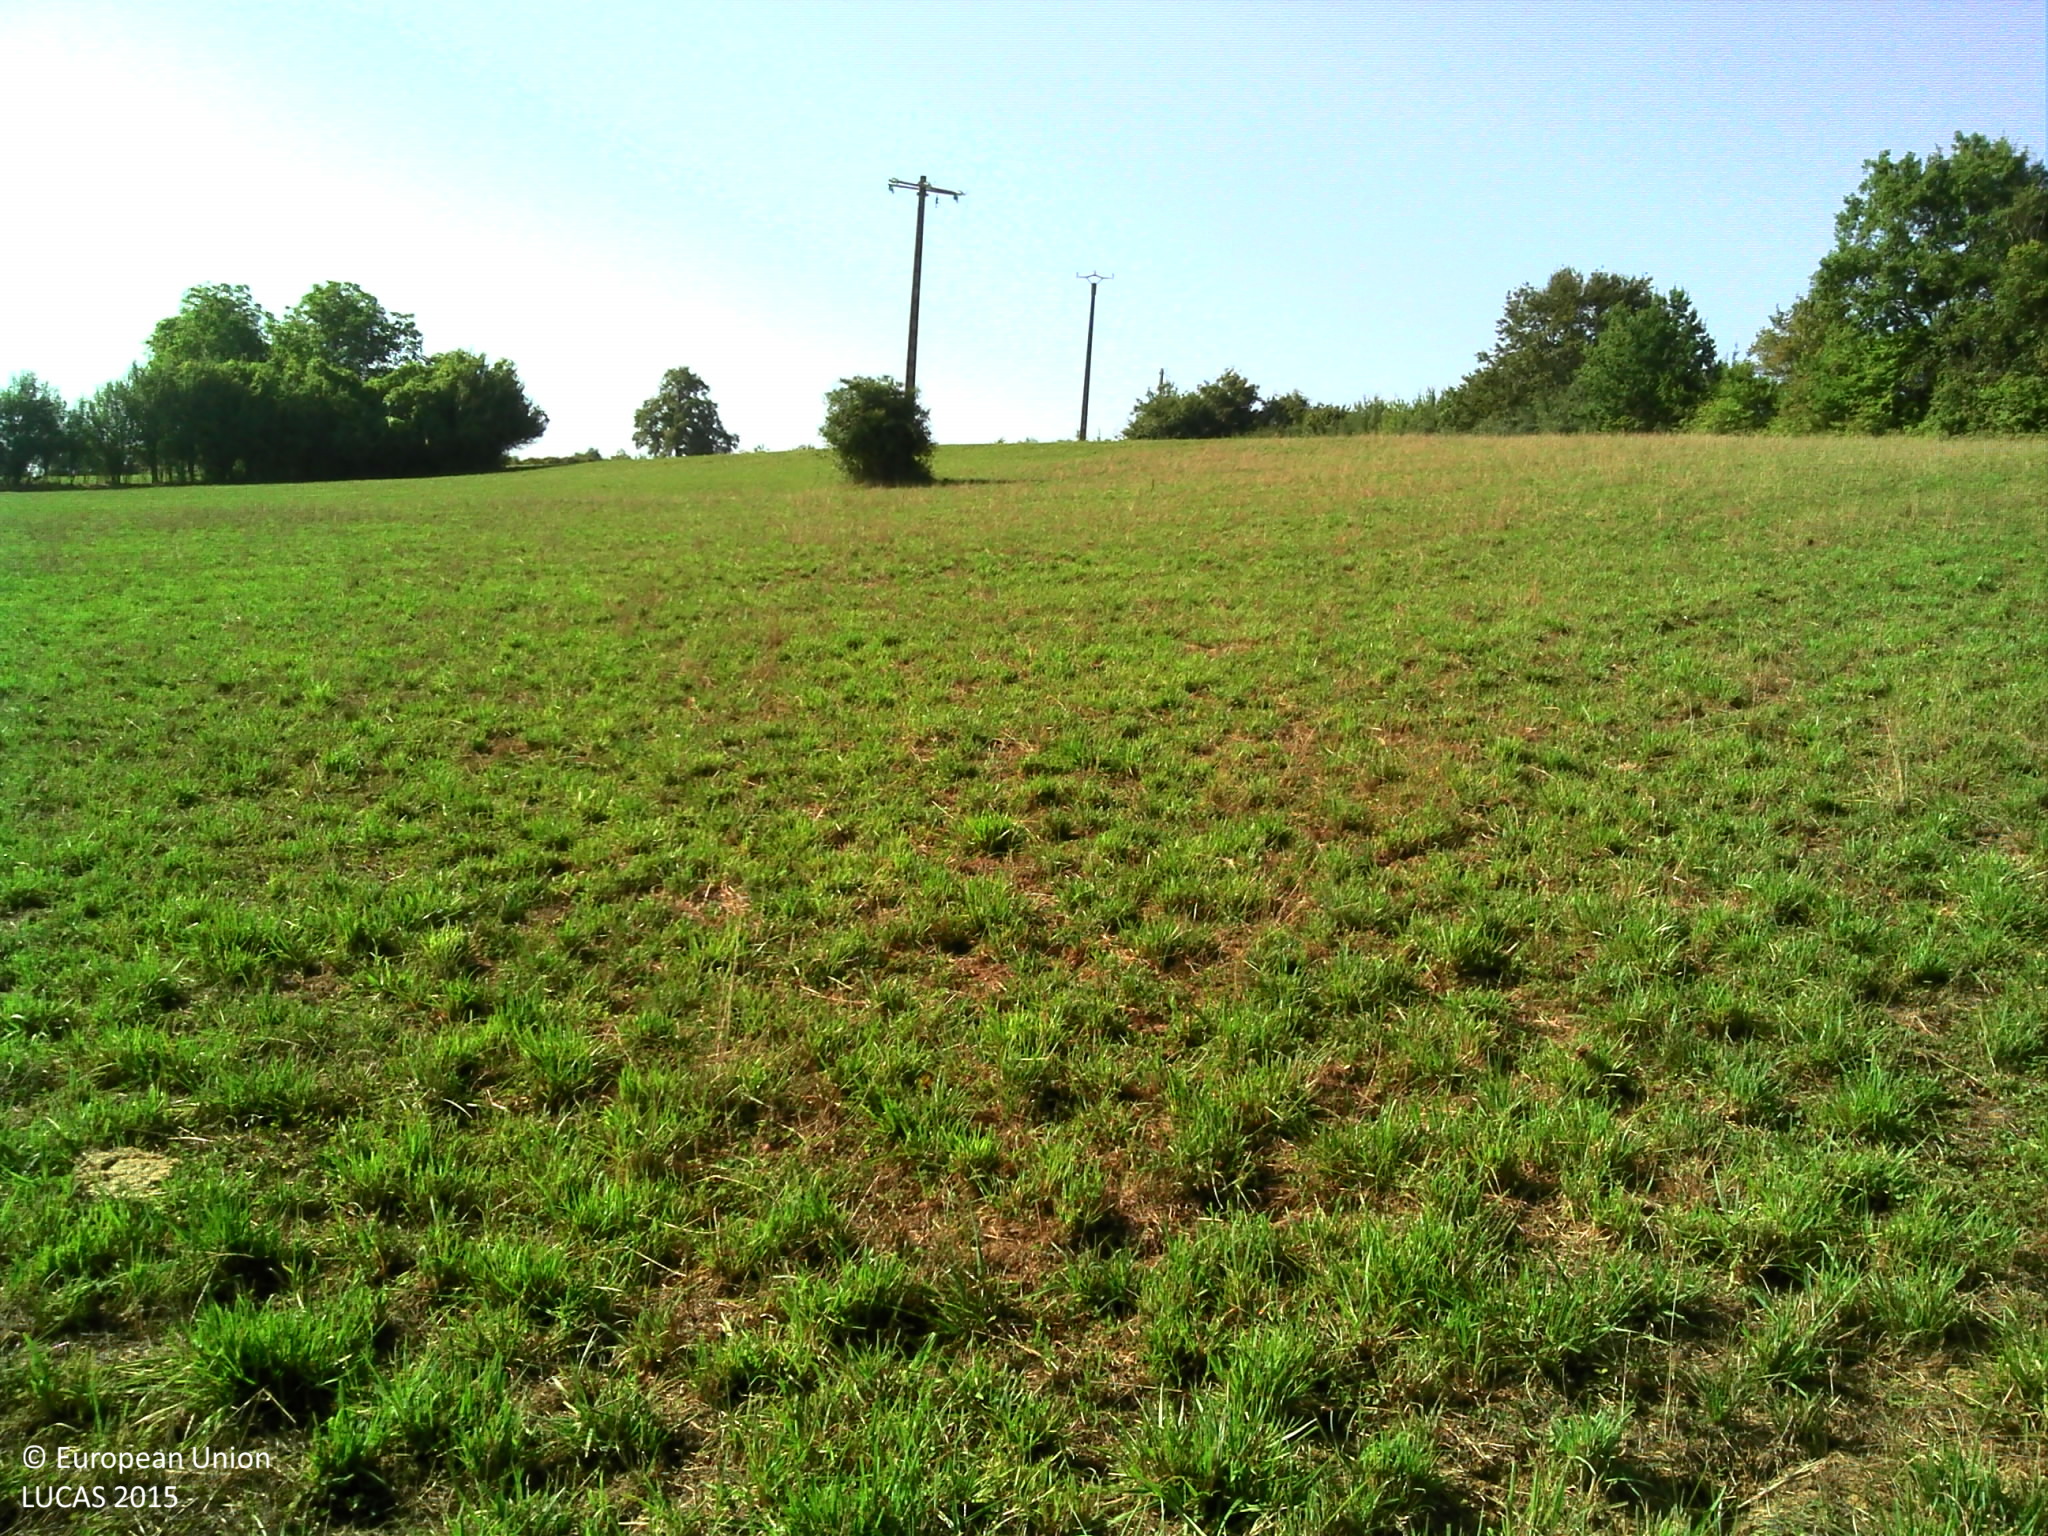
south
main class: Grassland
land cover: Grassland without tree/shrub cover
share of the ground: > 75 %
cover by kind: herbaceous plants 100 %
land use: Agriculture (excluding fallow land and kitchen gardens)
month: August
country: FR
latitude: 44.1294
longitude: 1.5139
